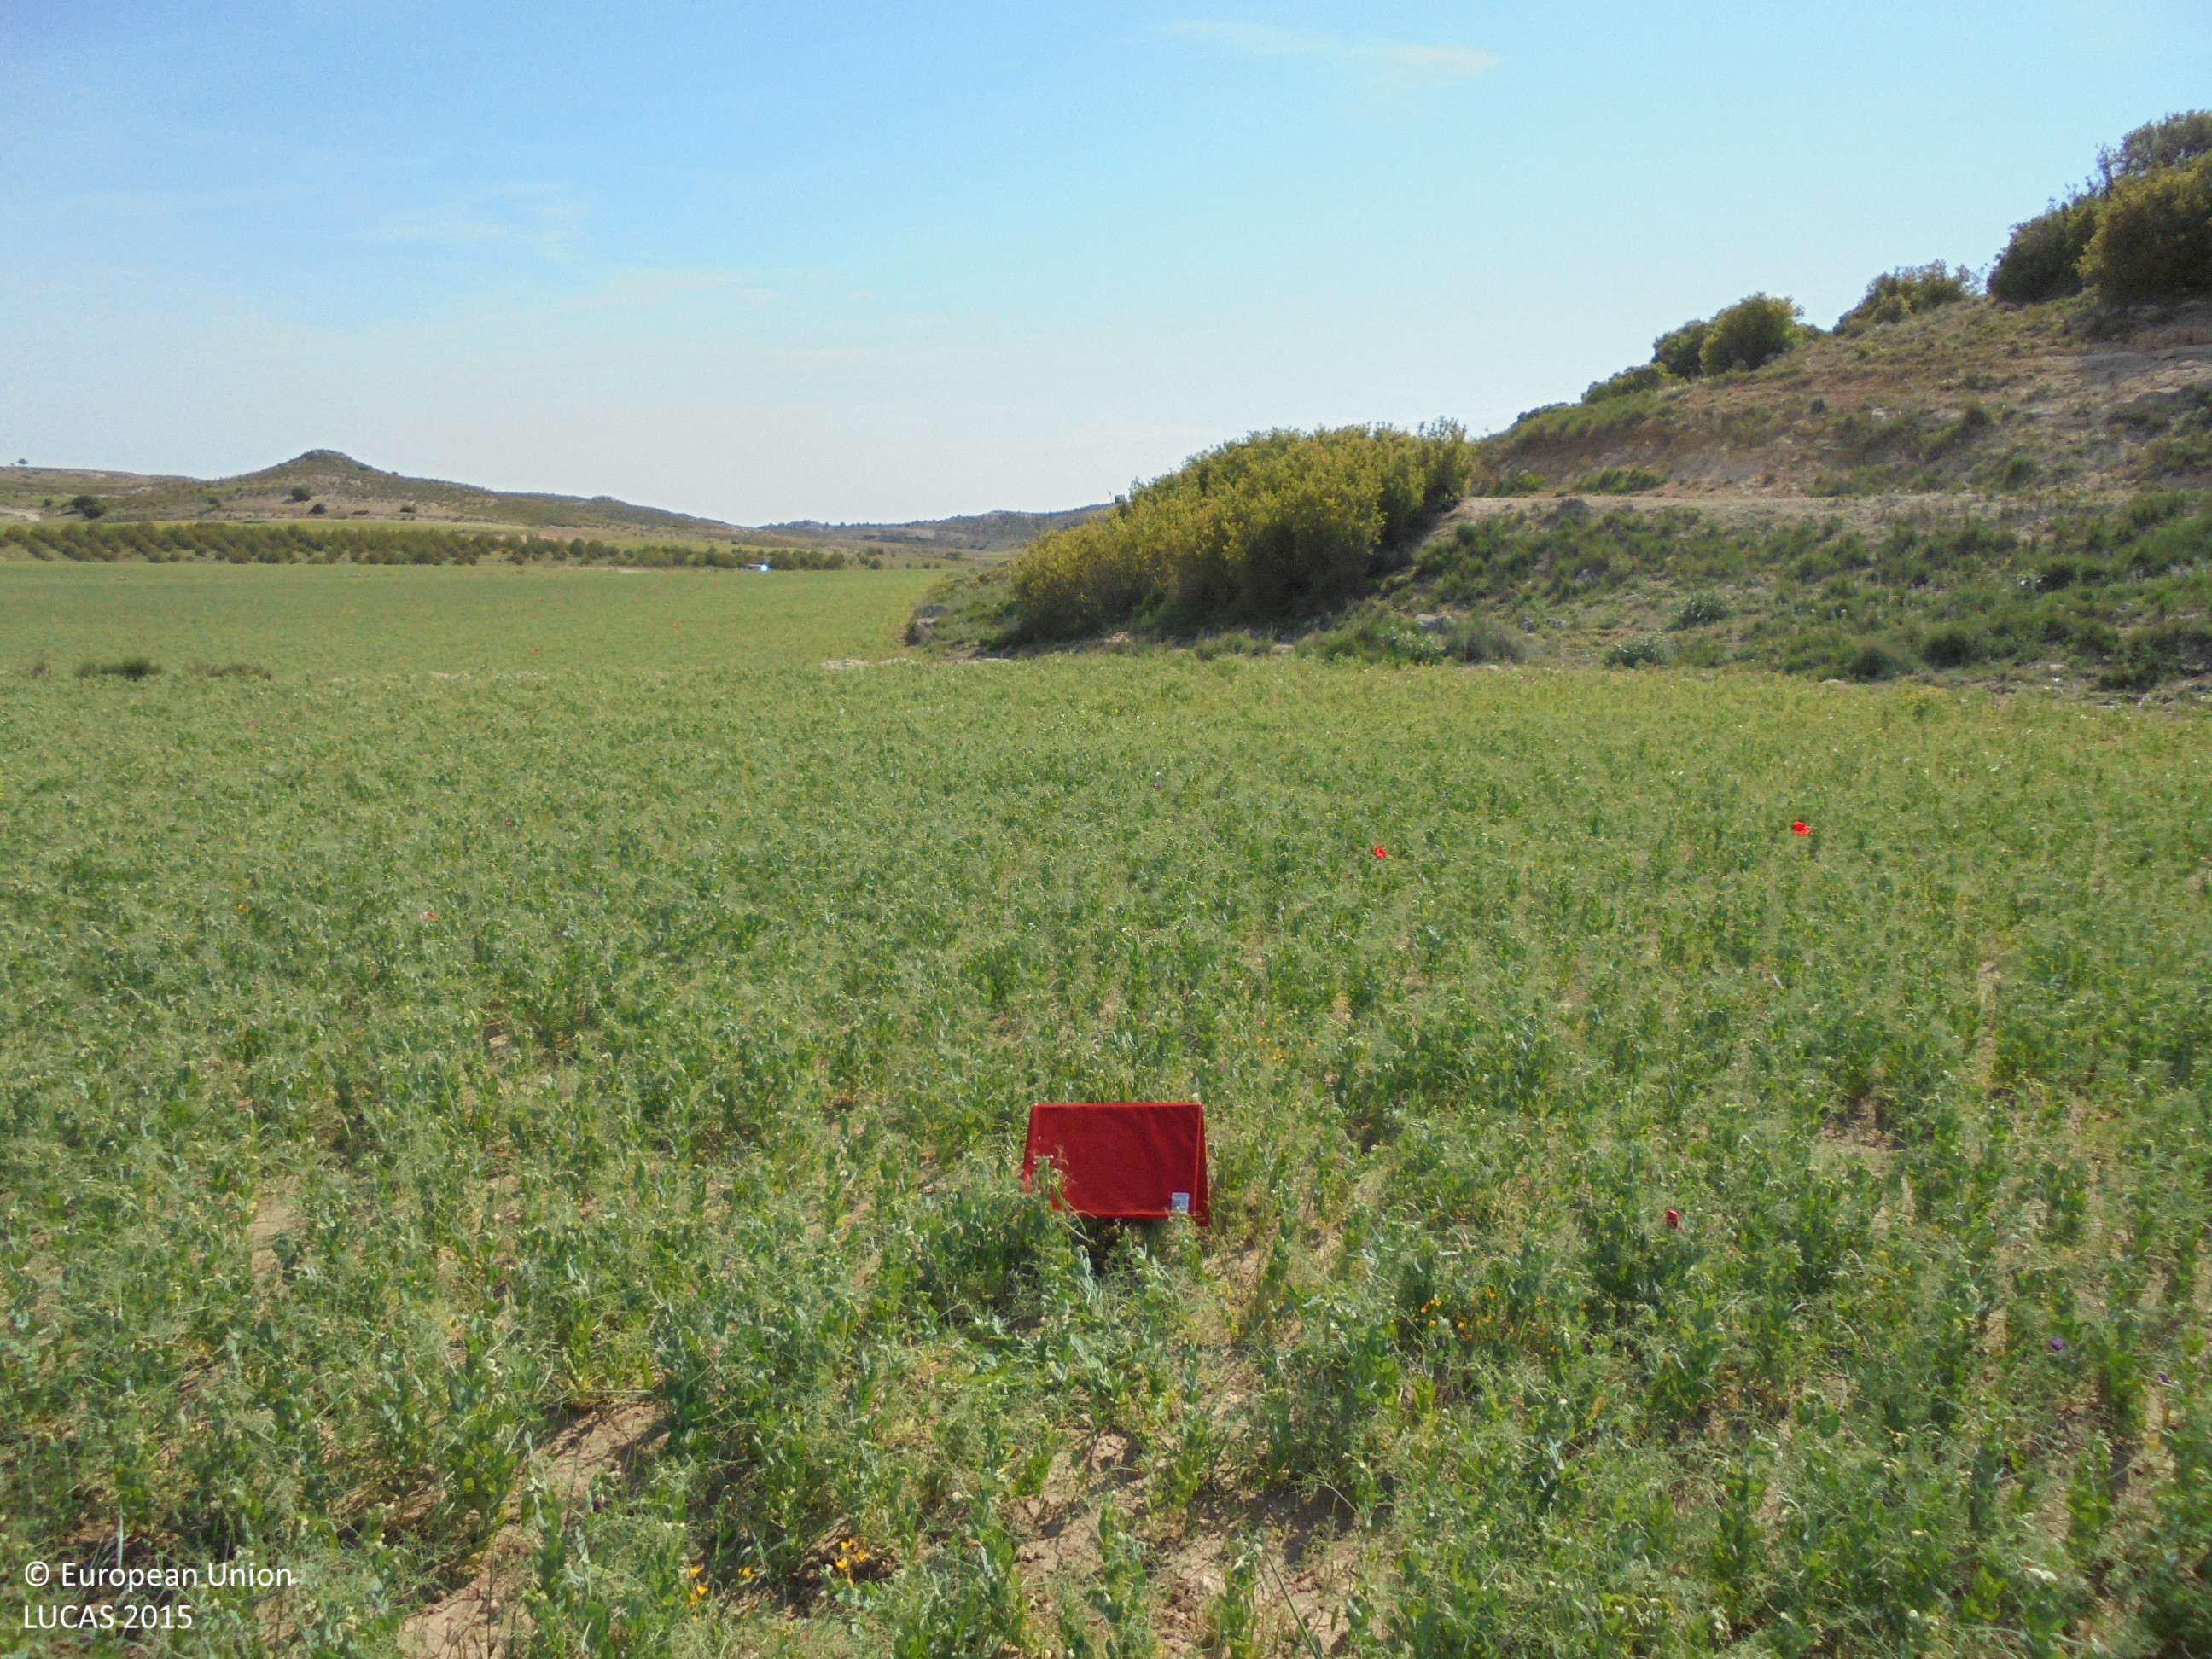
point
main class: Cropland
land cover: Dry pulses
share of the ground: 50 - 75 %
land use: Agriculture (excluding fallow land and kitchen gardens)
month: May
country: ES
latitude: 39.1461
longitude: -1.5359
